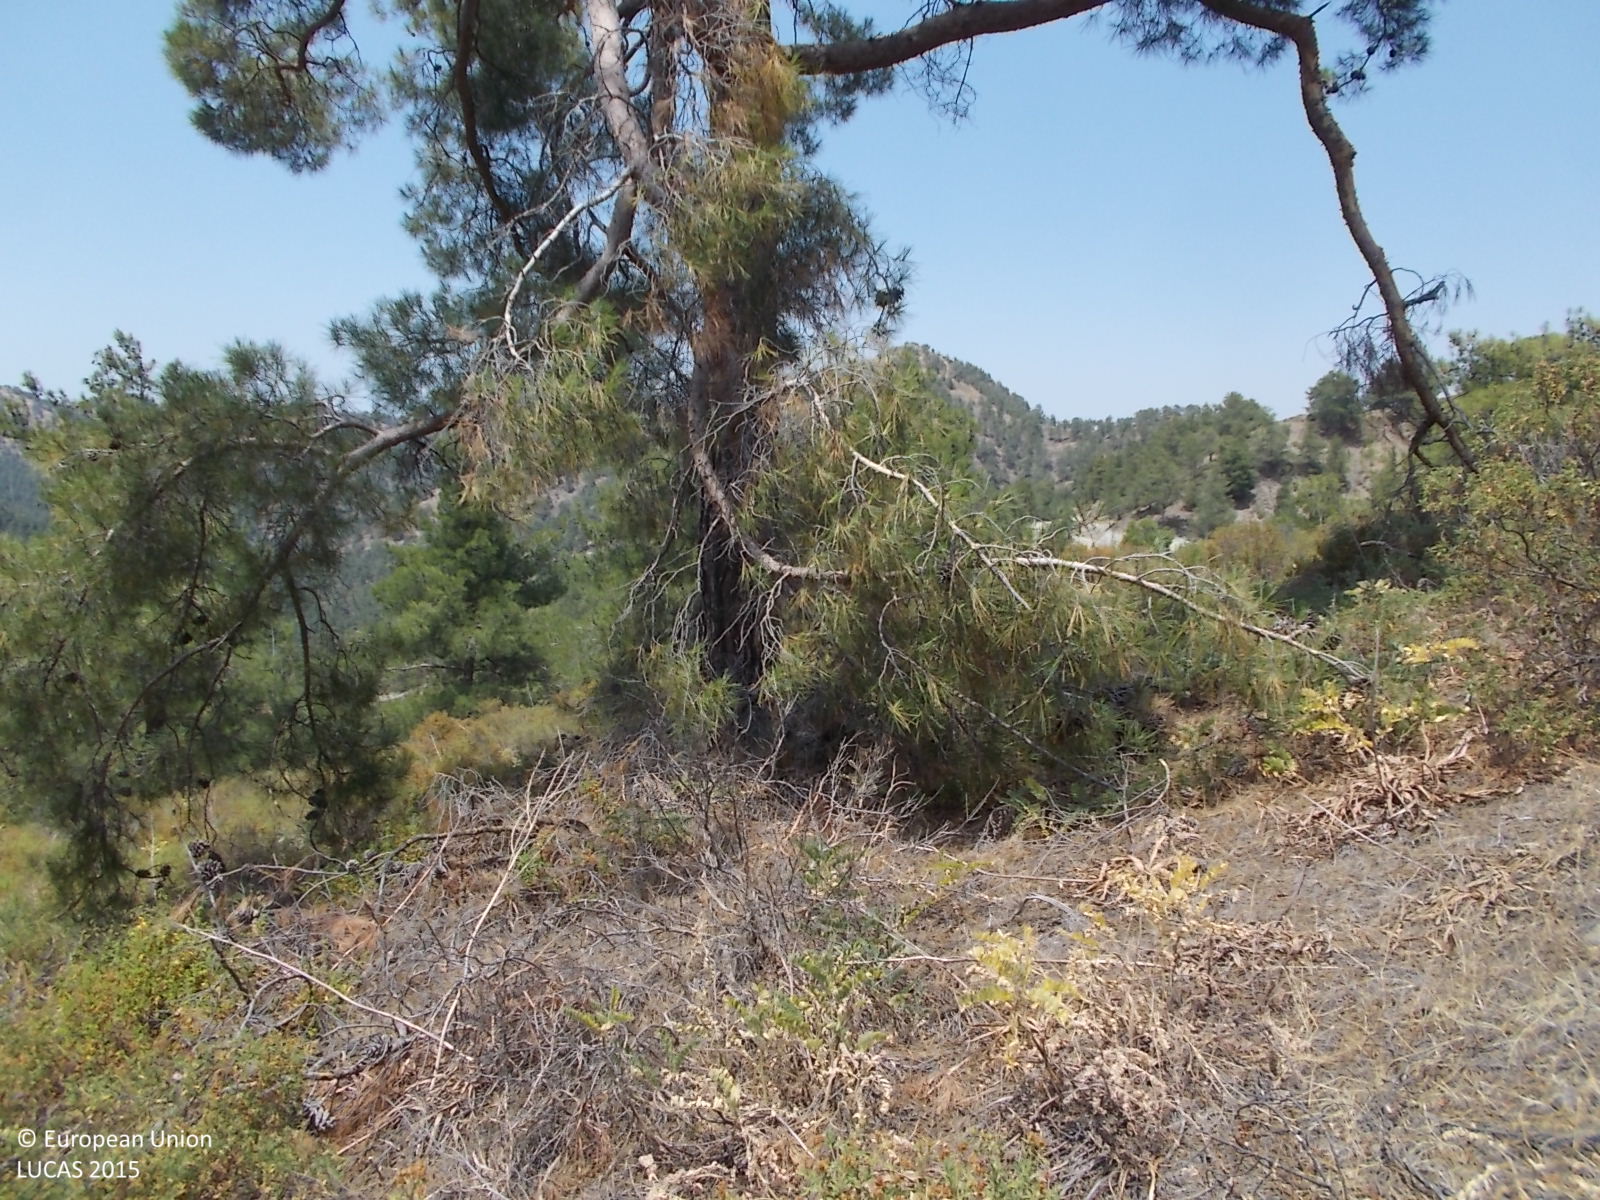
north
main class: Woodland
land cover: Pine dominated coniferous woodland
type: coniferous forest of the mediterranean region
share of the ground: 10 - 25 %
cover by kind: shrubs 55 %, unconsolidated bare surface 25 %, coniferous forest trees 20 %
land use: Forestry
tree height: > 5 m
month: June
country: CY
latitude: 34.9998
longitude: 32.9282
